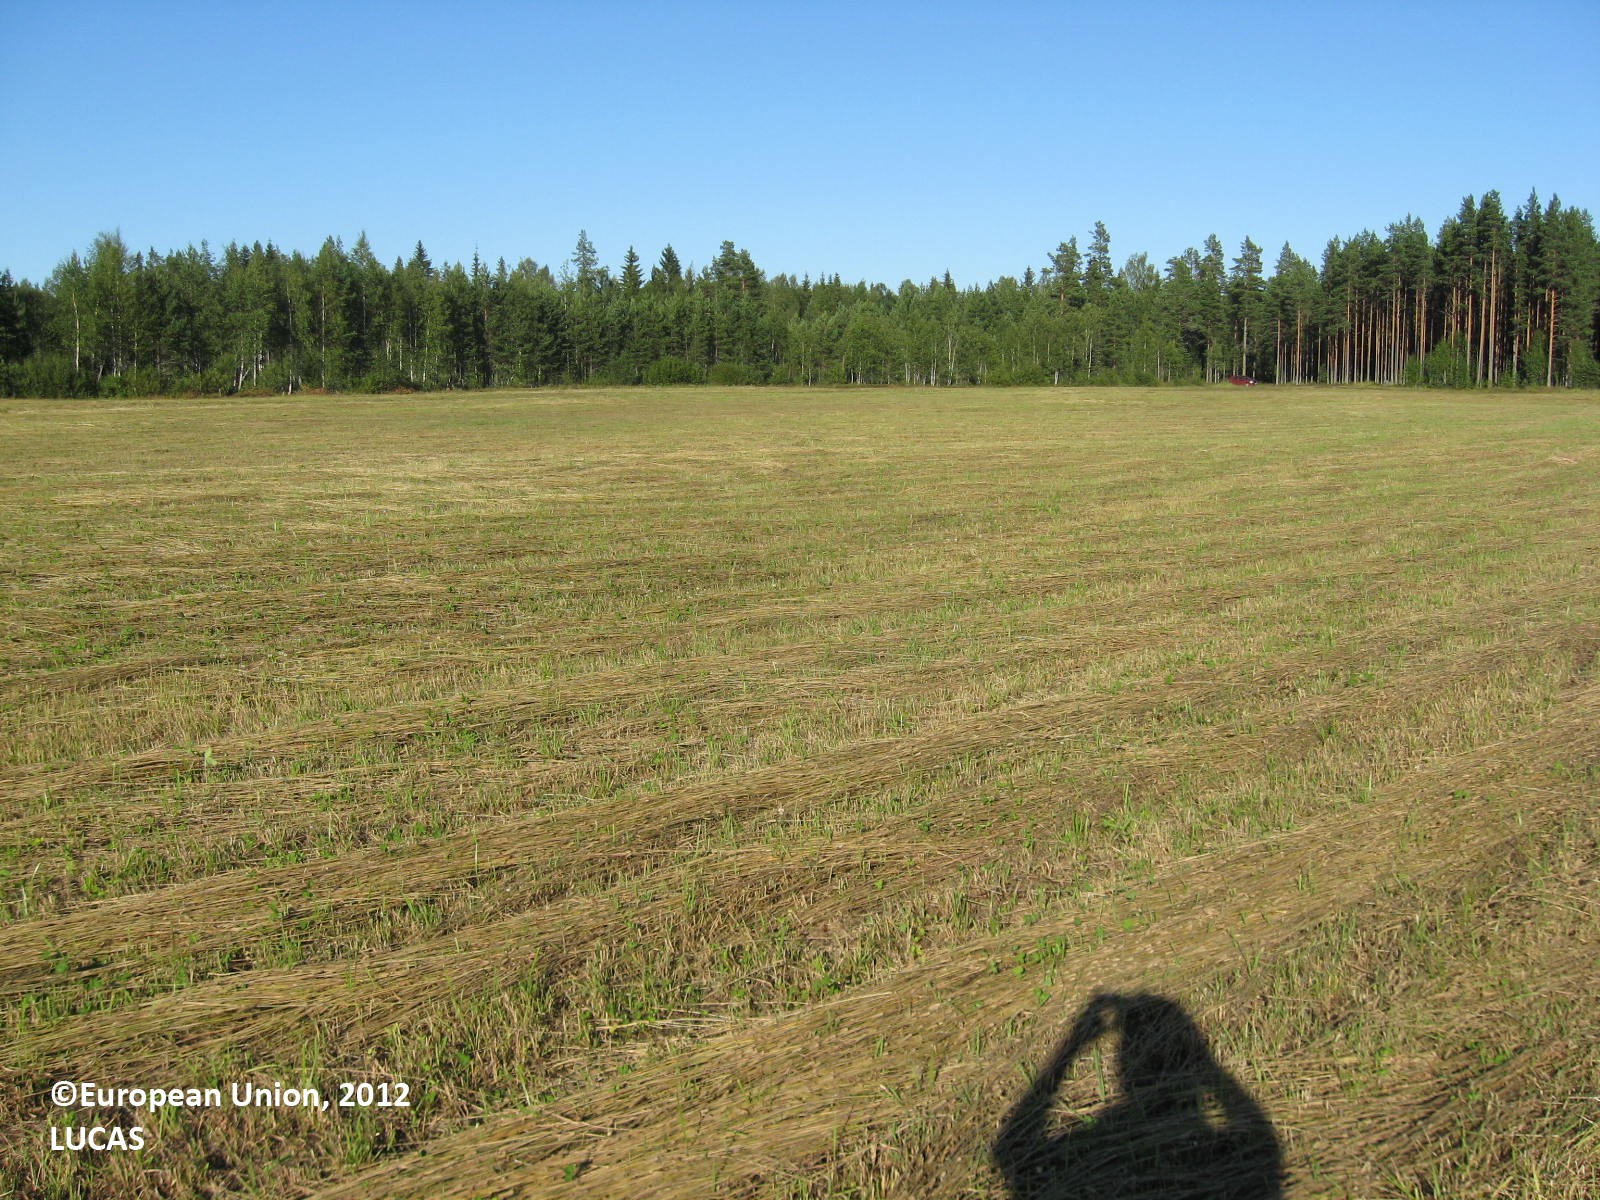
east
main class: Cropland
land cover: Temporary grasslands
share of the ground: > 75 %
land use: Agriculture (excluding fallow land and kitchen gardens)
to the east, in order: Temporary grasslands; Shruby margins; Ditches and canals; Other mixed woodland; Paved roads, cycling and walking lanes; Shruby margins; Ditches and canals; Pine dominated coniferous woodland
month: July
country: FI
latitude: 62.1110
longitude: 22.4570
